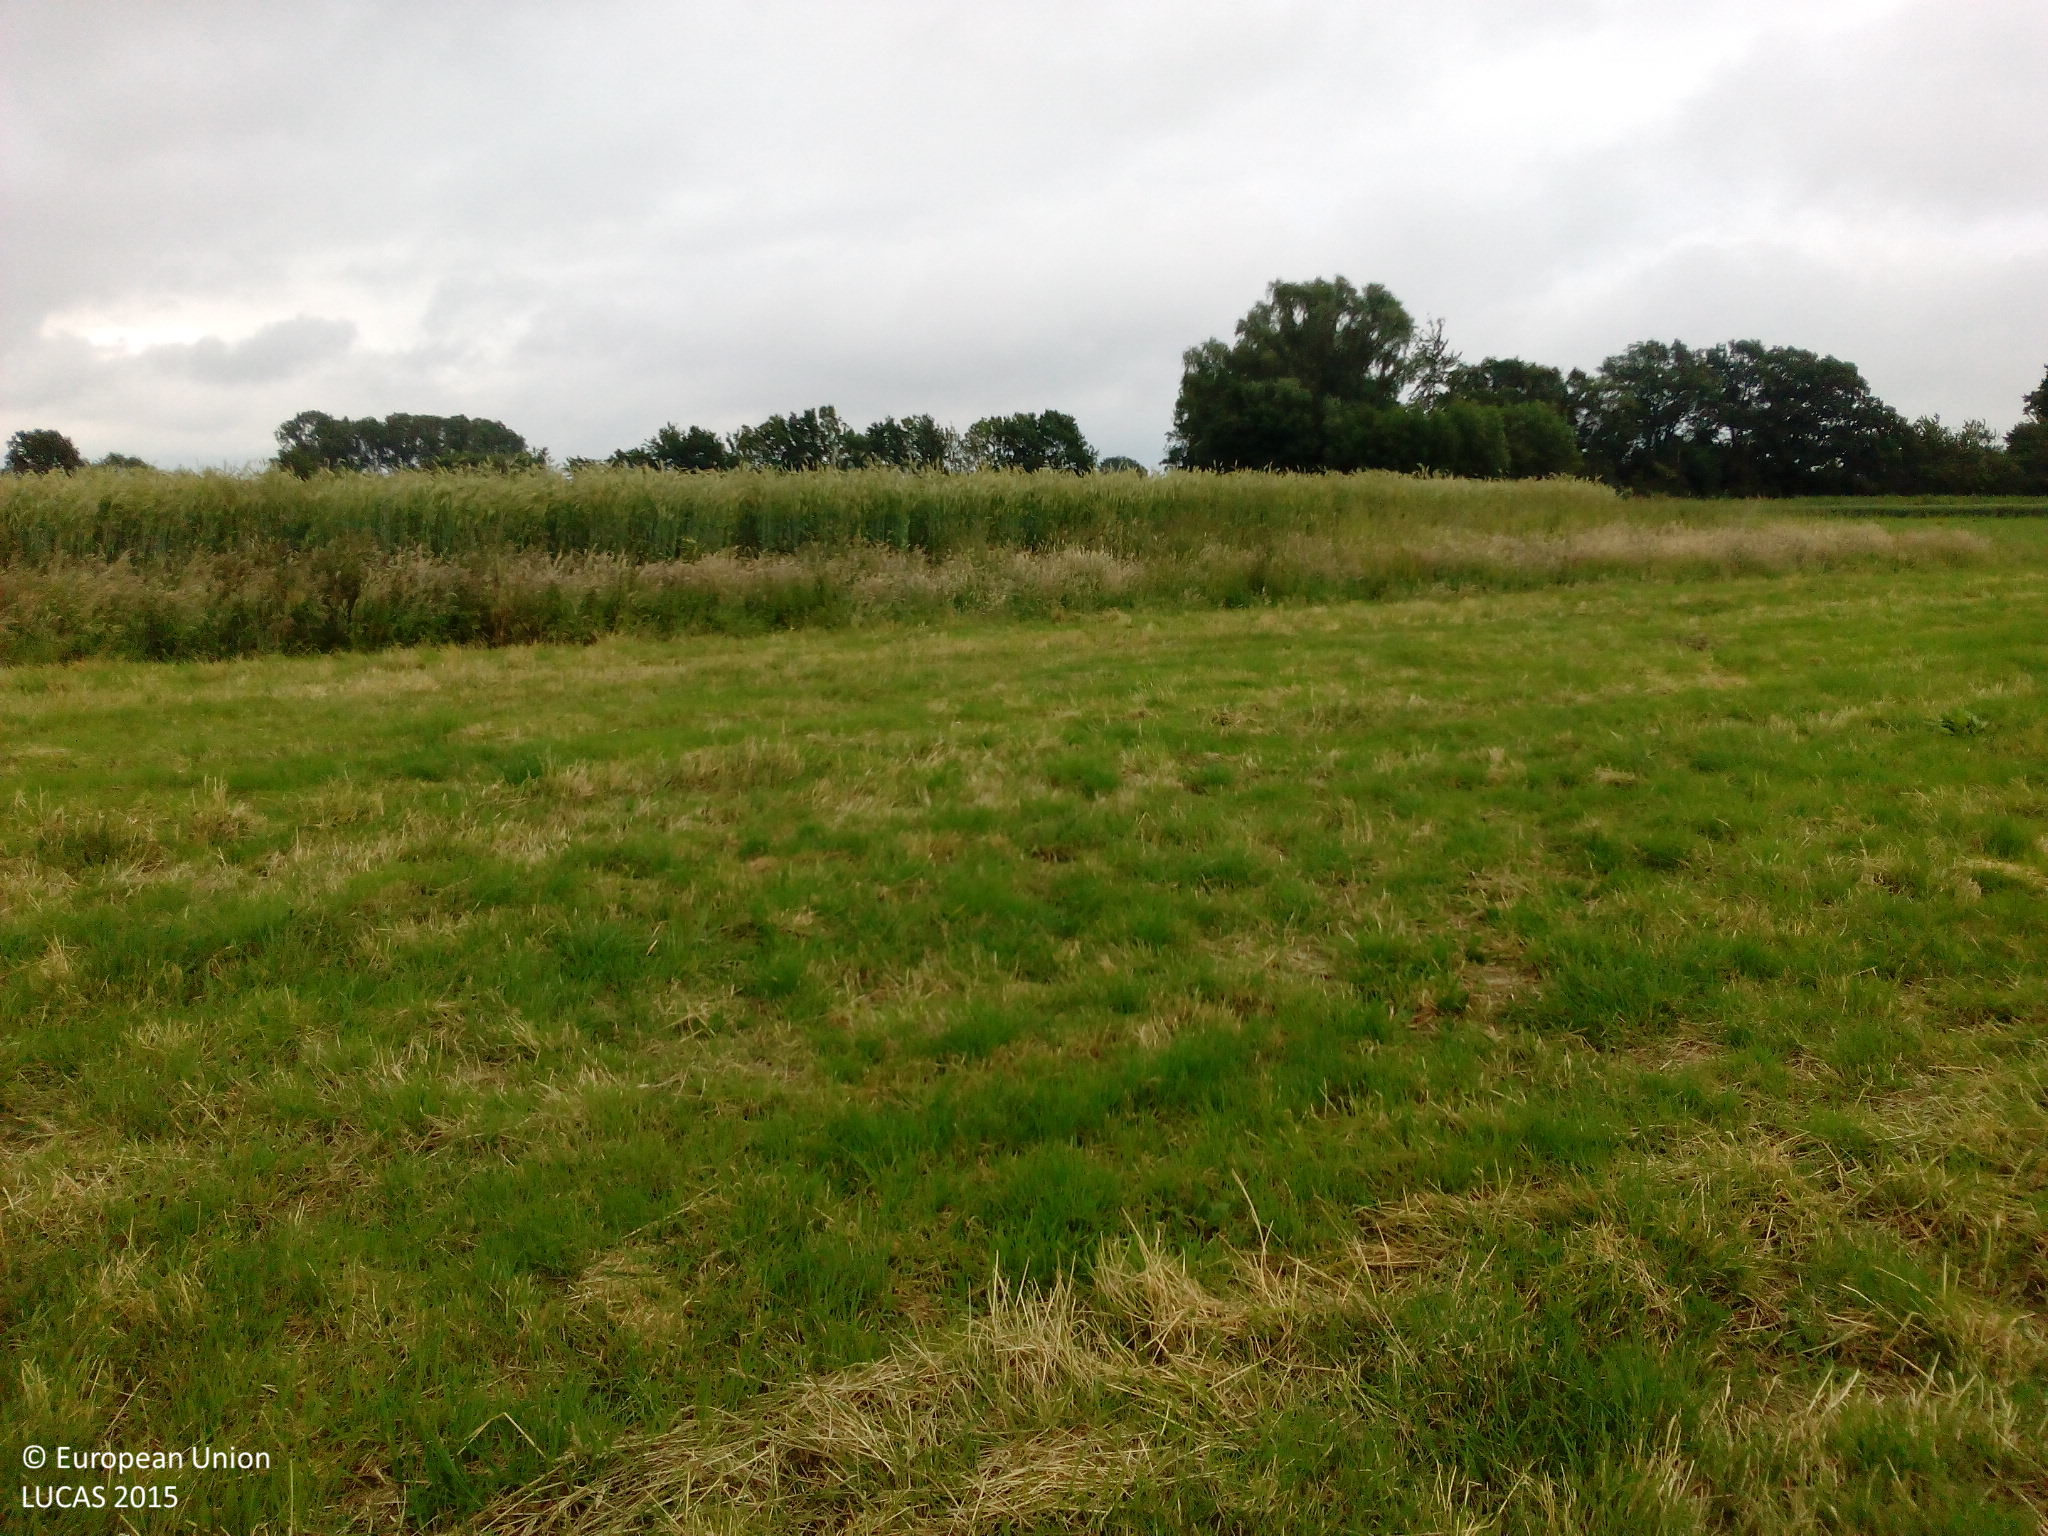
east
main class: Grassland
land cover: Grassland without tree/shrub cover
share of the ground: > 75 %
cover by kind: herbaceous plants 100 %
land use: Agriculture (excluding fallow land and kitchen gardens)
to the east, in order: Grassland without tree/shrub cover; Barley; Abandoned hedges; Grass margins; Paved roads, cycling and walking lanes; Grass margins; Rye
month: June
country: DE
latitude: 51.6318
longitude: 8.5701
